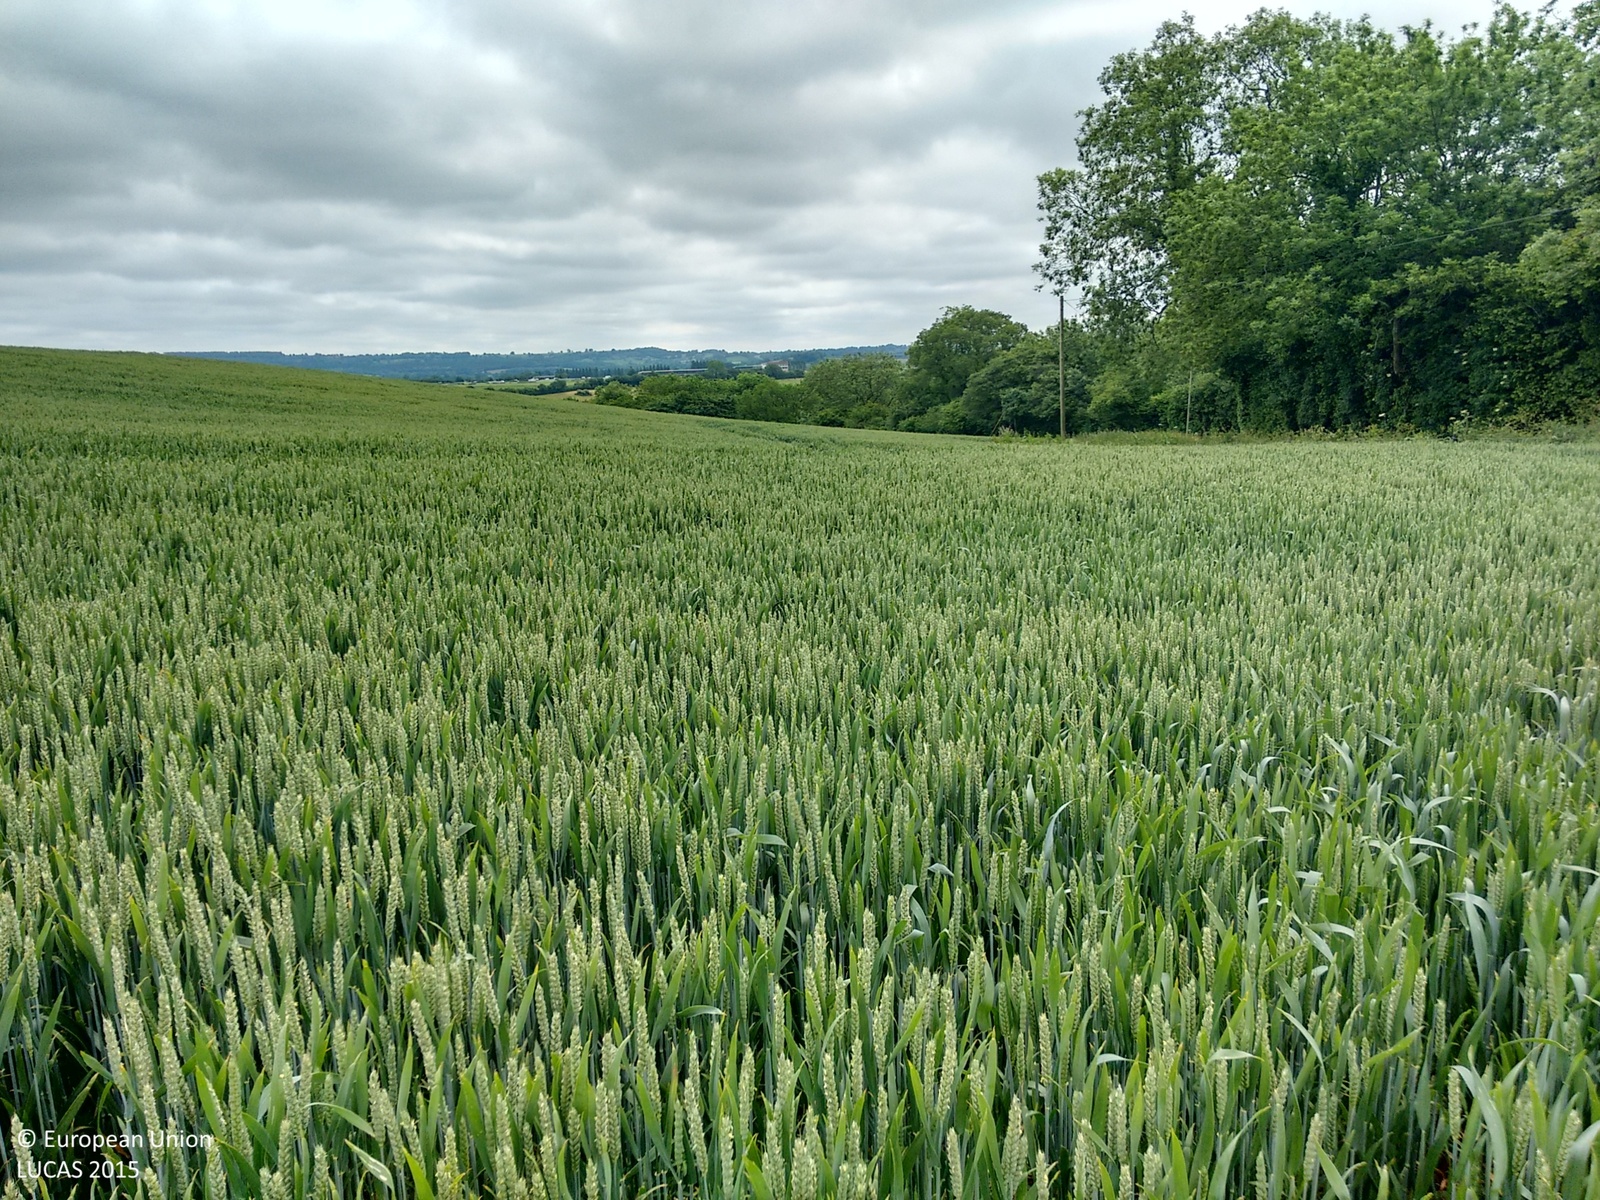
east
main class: Cropland
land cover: Common wheat
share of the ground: > 75 %
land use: Agriculture (excluding fallow land and kitchen gardens)
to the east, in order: Common wheat; Grass margins; Managed hedges; Fences; Managed hedges; Paved roads, cycling and walking lanes; Electric lines; Paved roads, cycling and walking lanes; Broadleaved woodland; Rivers and streams; Broadleaved woodland
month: June
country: GB
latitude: 51.0651
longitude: -2.4371
